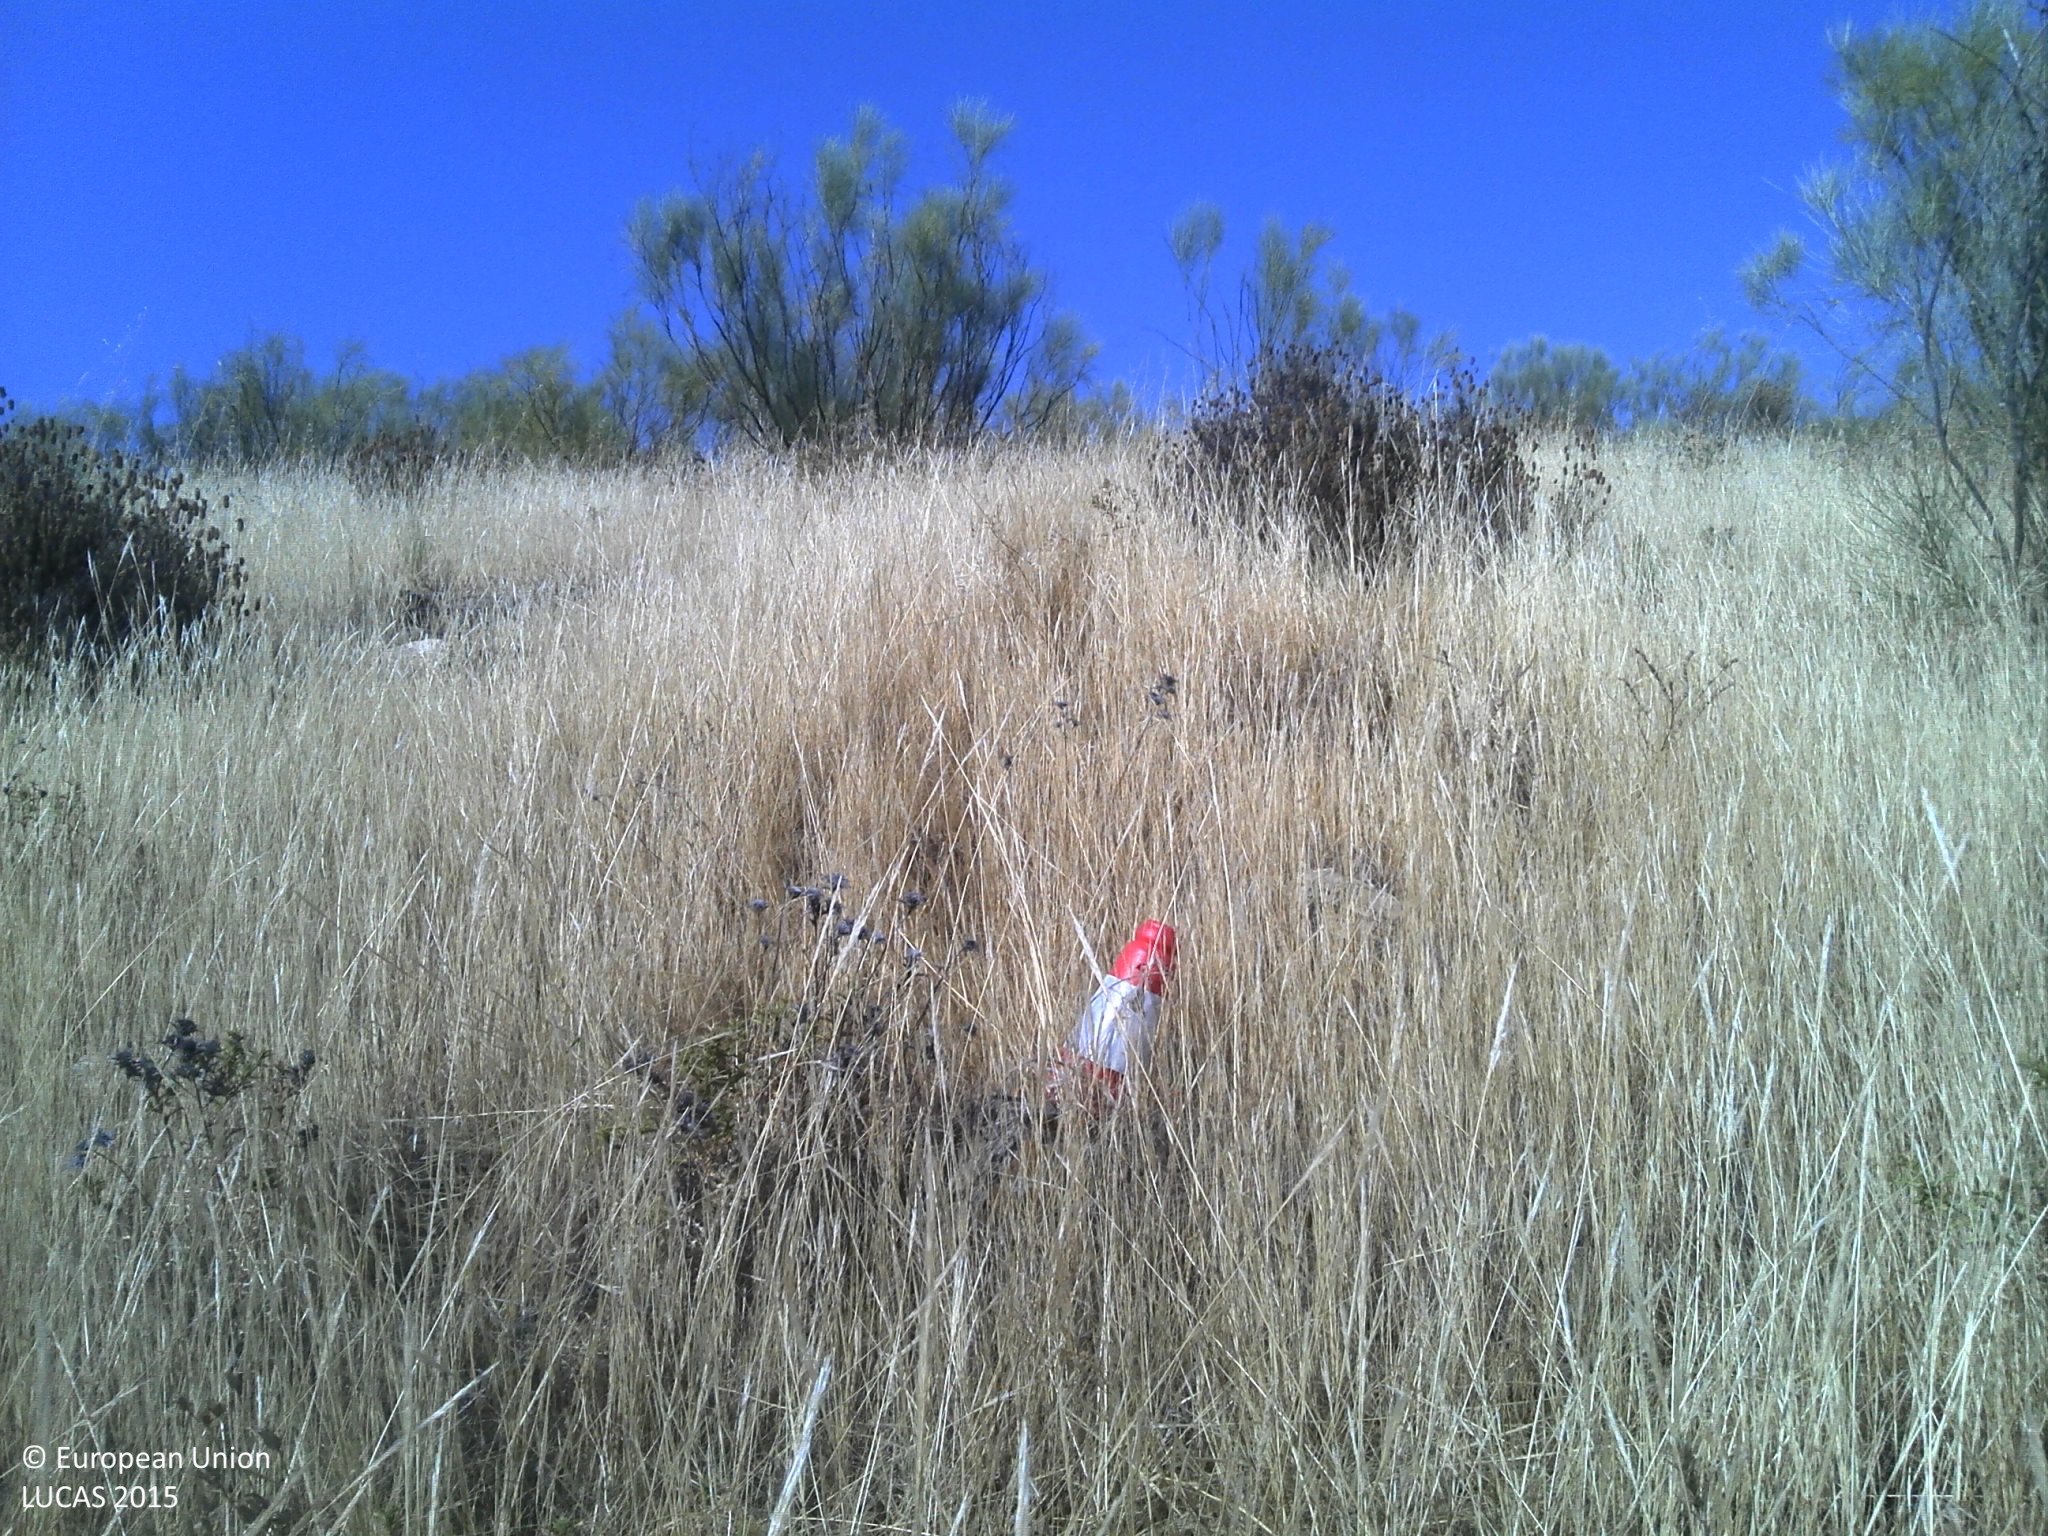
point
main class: Shrubland
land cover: Shrubland without tree cover
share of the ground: 50 - 75 %
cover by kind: shrubs 55 %, herbaceous plants 45 %
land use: Agriculture (excluding fallow land and kitchen gardens)
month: June
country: PT
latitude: 39.7385
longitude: -7.1612
